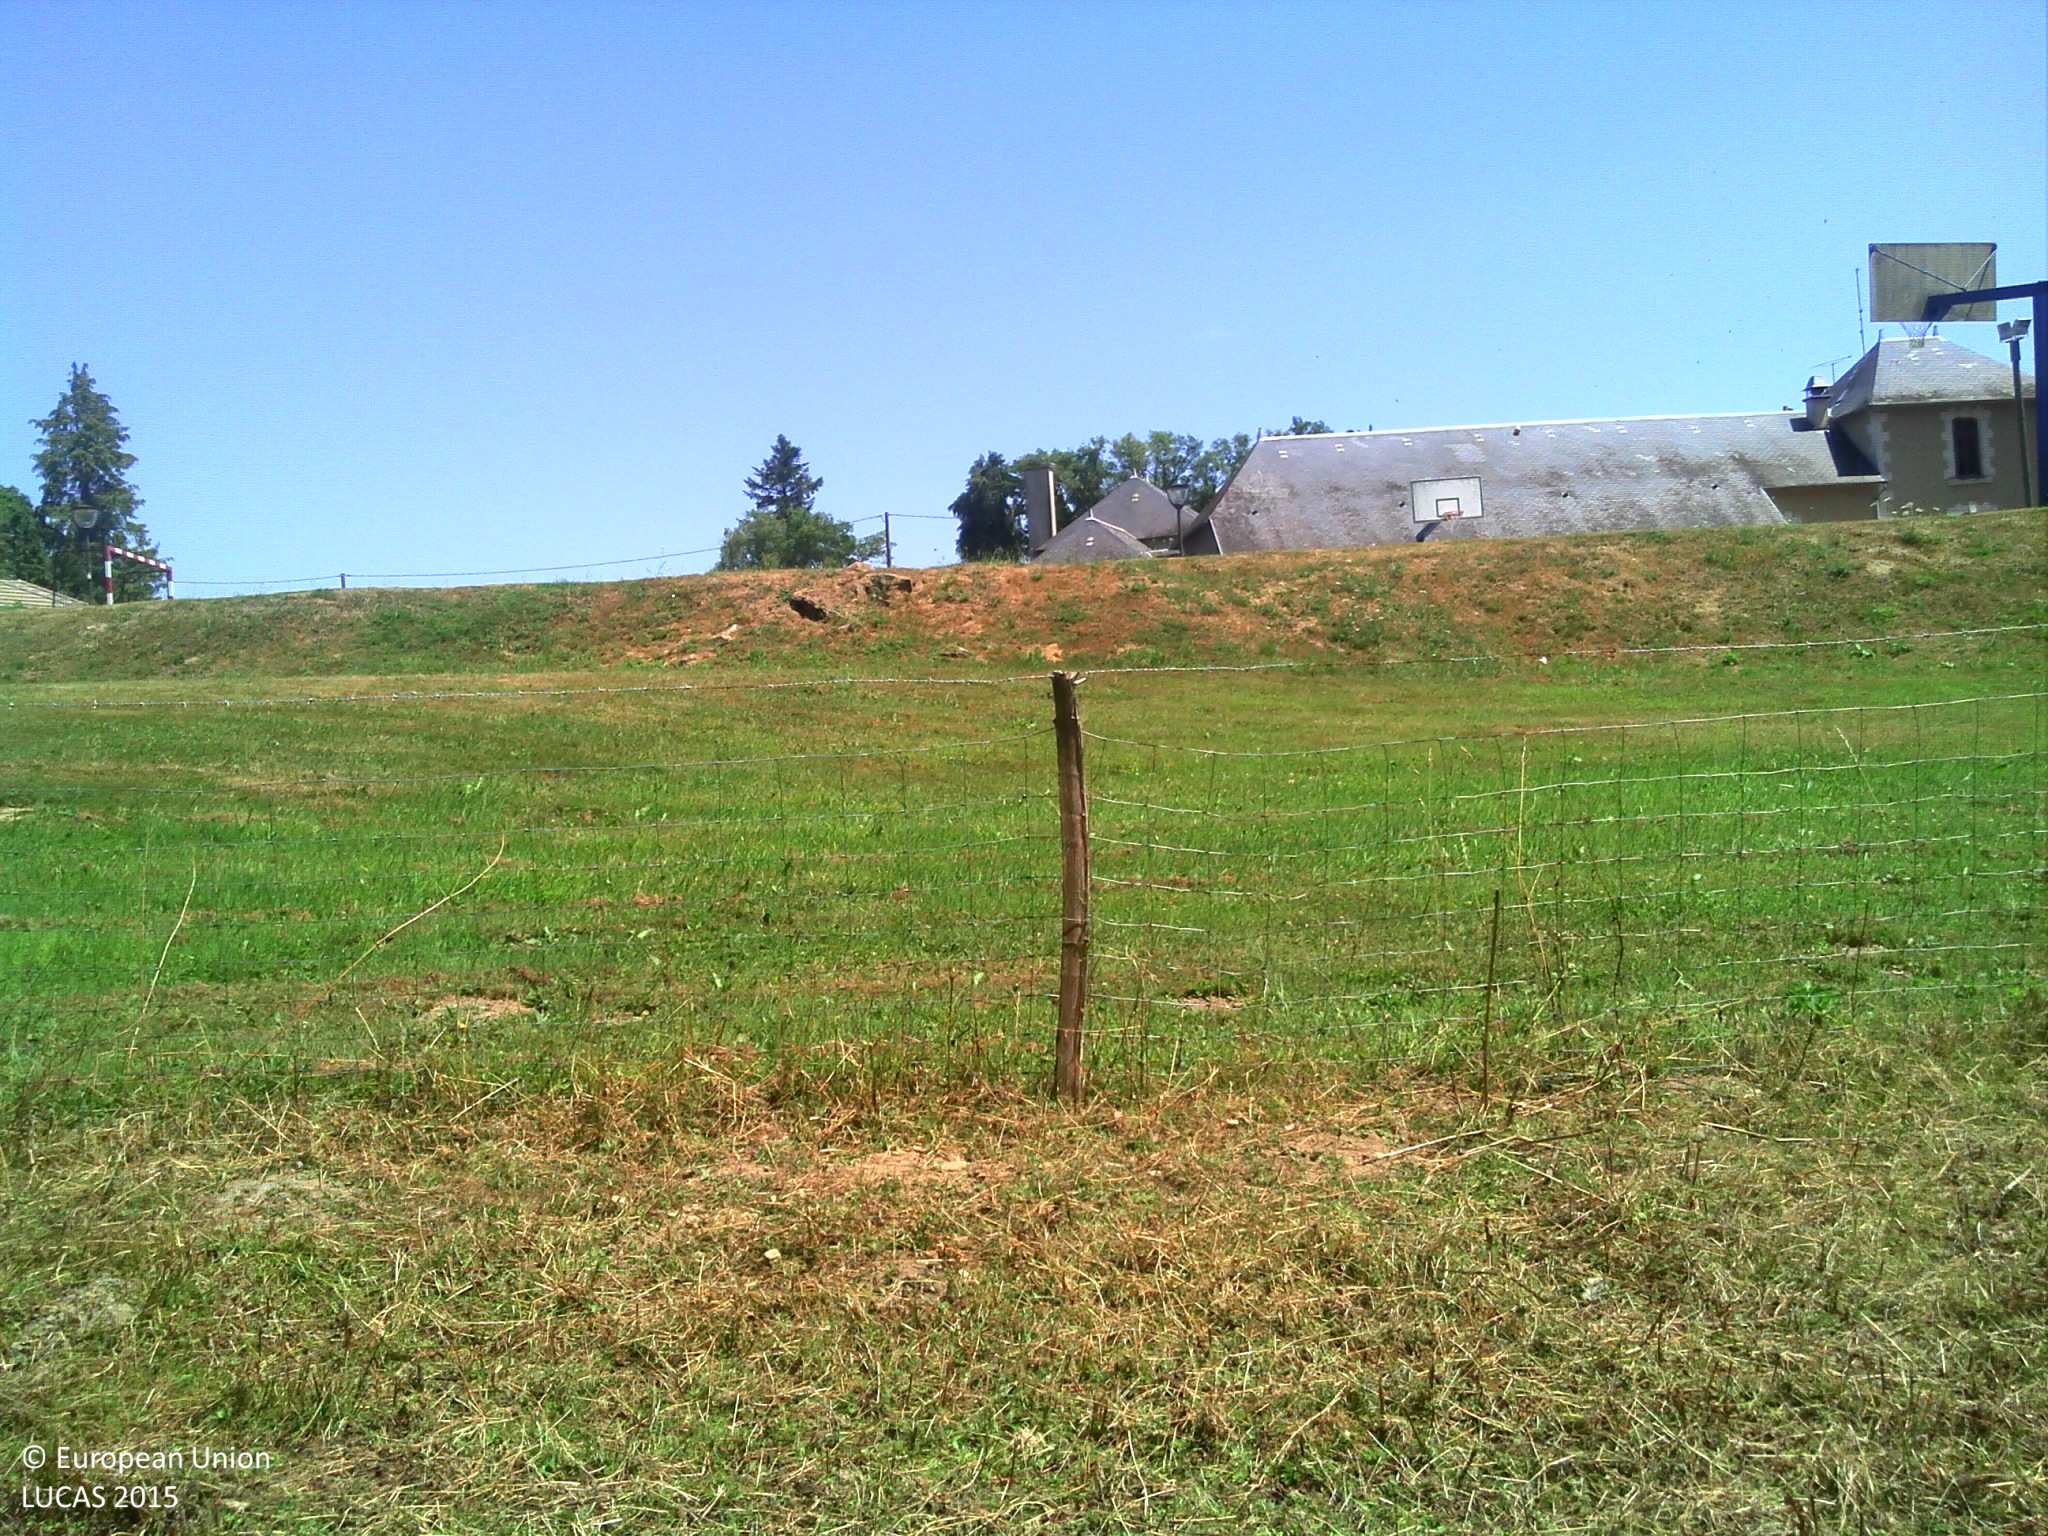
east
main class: Grassland
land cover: Grassland without tree/shrub cover
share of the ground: > 75 %
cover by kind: herbaceous plants 95 %, shrubs 5 %
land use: Community services
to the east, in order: Grassland without tree/shrub cover; Fences; Grassland without tree/shrub cover; Artificial constructions in urban areas; Broadleaved woodland; Fences; Managed hedges; Grassland without tree/shrub cover; Electric lines; Grassland without tree/shrub cover; Fences; Grassland without tree/shrub cover
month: July
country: FR
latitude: 46.1344
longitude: 1.6692
